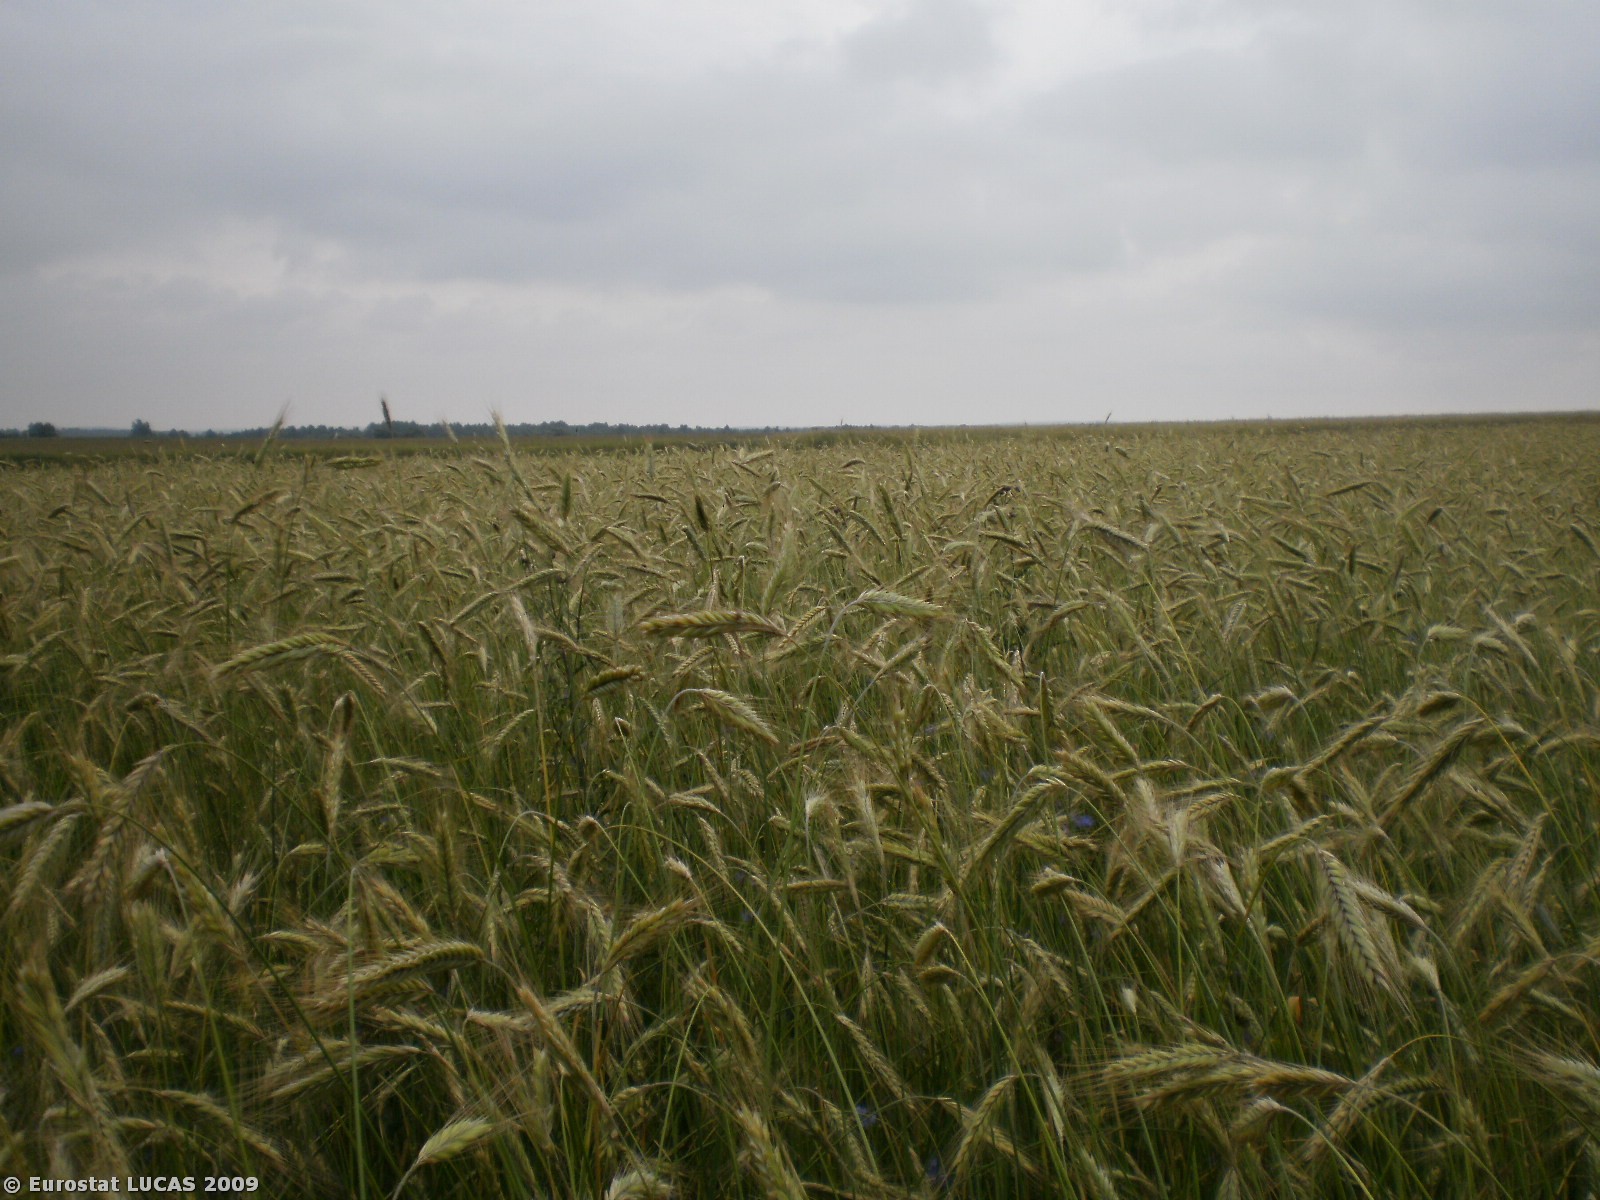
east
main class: Cropland
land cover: Triticale
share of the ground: > 75 %
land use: Agriculture (excluding fallow land and kitchen gardens)
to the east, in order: Triticale; Grassland without tree/shrub cover; Triticale; Grass margins; Common wheat; Tracks; Triticale; Grass margins; Ditches and canals; Grassland without tree/shrub cover
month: July
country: PL
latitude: 53.1295
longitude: 20.4540
